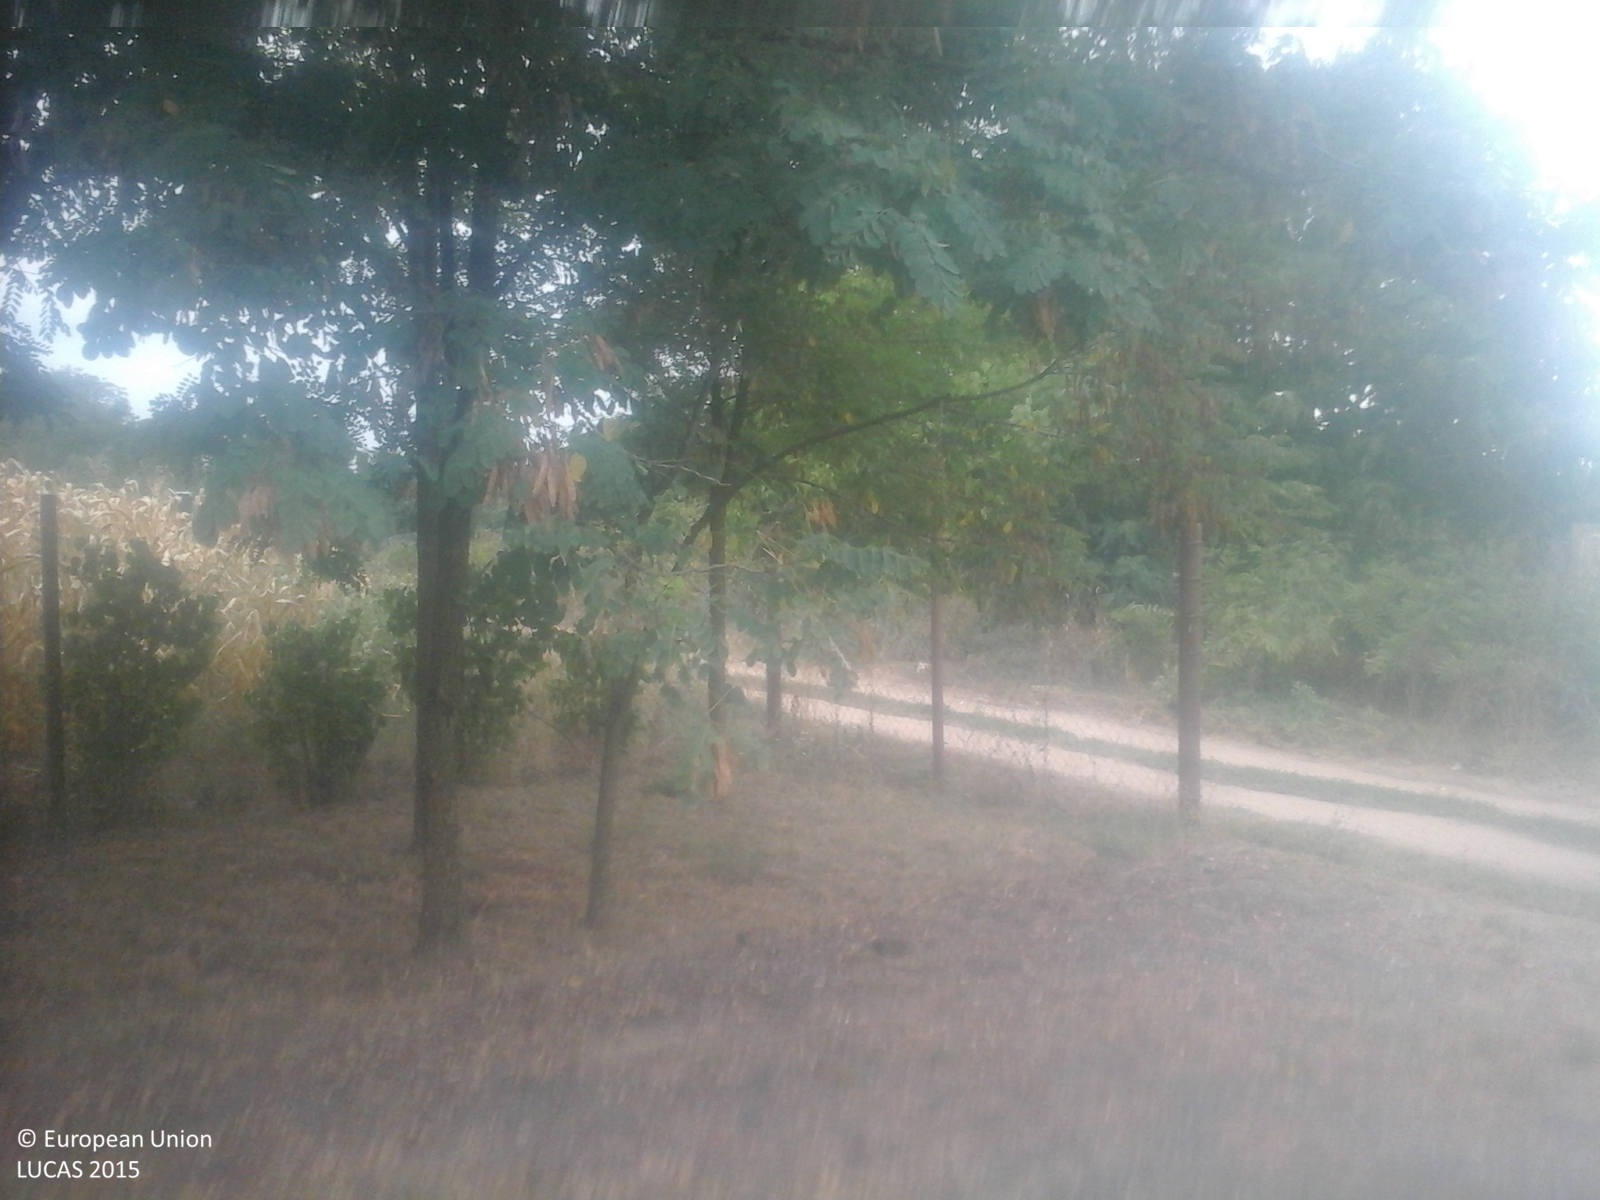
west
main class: Grassland
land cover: Grassland with sparse tree/shrub cover
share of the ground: > 75 %
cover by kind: herbaceous plants 85 %, shrubs 10 %, broadleaved forest trees 5 %
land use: Agriculture (excluding fallow land and kitchen gardens)
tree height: < 5 m
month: September
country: RO
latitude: 47.6597
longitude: 22.4539
